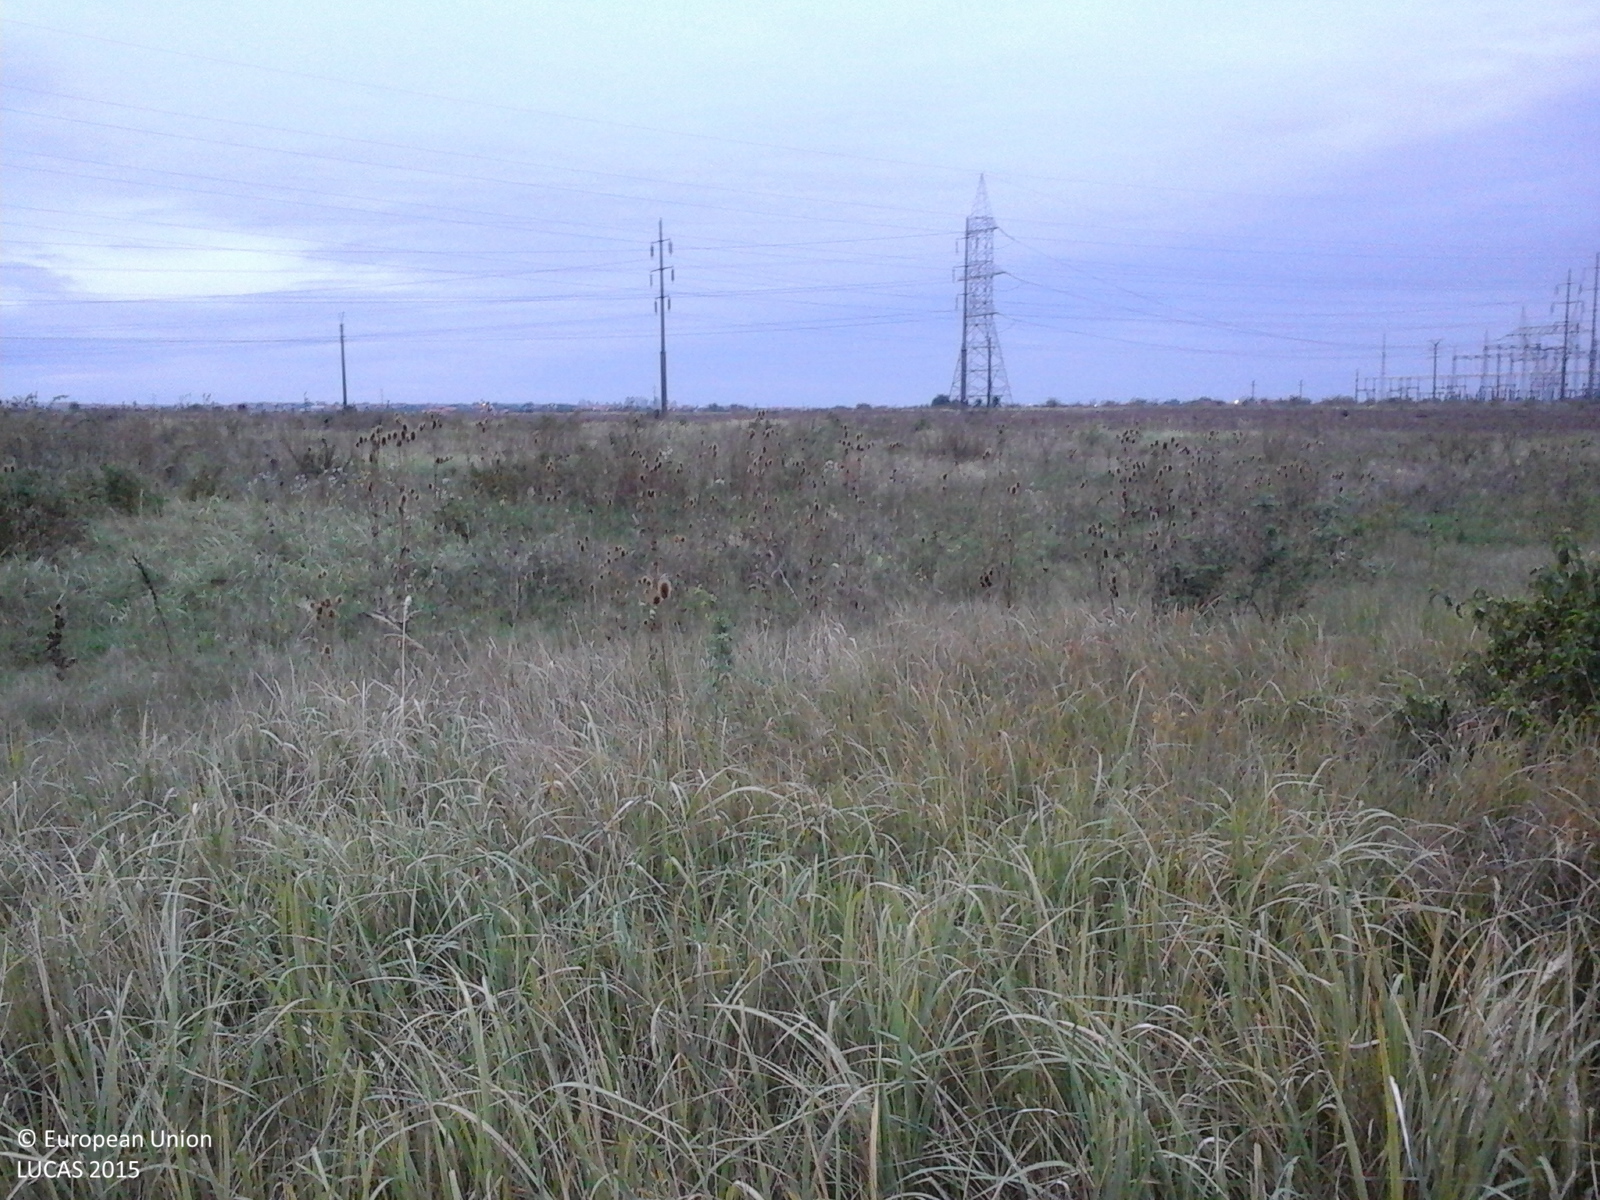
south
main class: Grassland
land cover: Grassland with sparse tree/shrub cover
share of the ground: > 75 %
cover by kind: herbaceous plants 85 %, shrubs 10 %, broadleaved forest trees 5 %
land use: Agriculture (excluding fallow land and kitchen gardens)
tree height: < 5 m
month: September
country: RO
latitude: 47.0247
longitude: 21.9538
